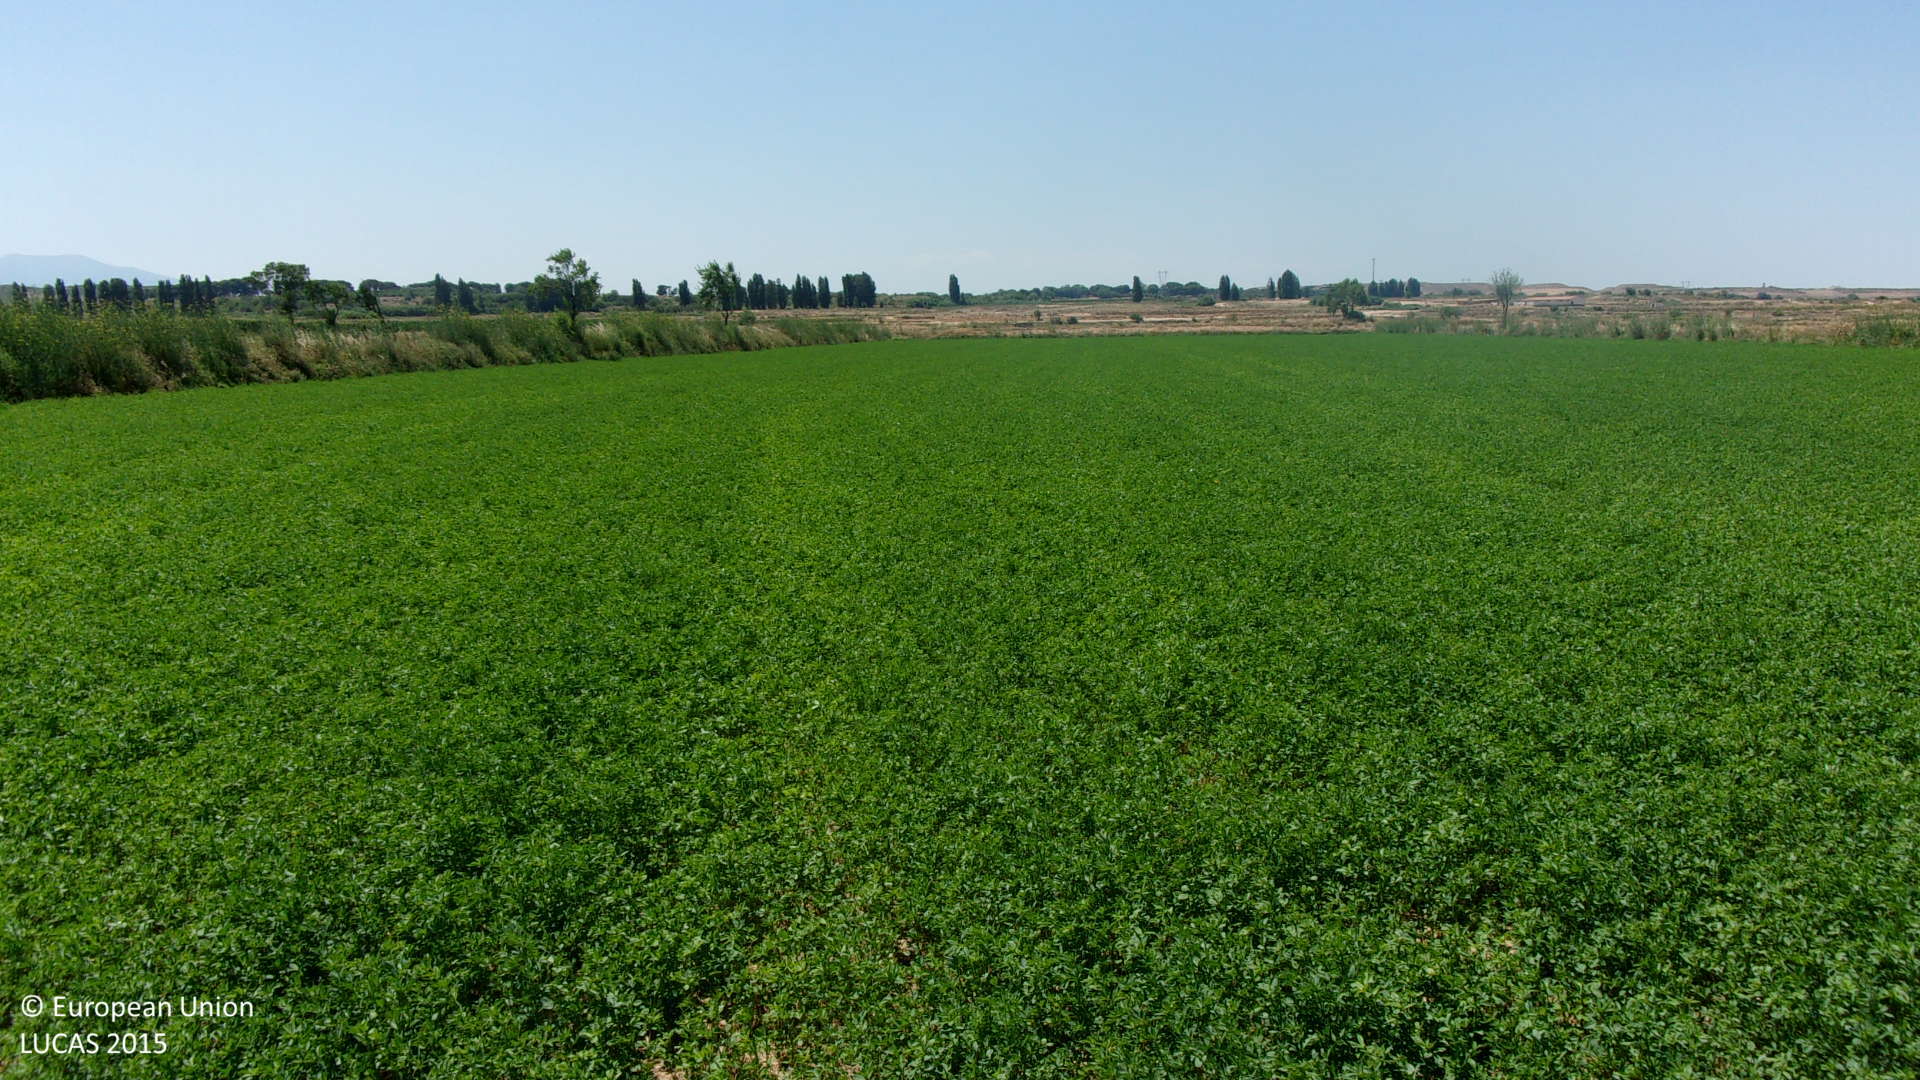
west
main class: Cropland
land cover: Lucerne
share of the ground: > 75 %
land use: Agriculture (excluding fallow land and kitchen gardens)
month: July
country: ES
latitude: 41.9598
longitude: -1.5039
